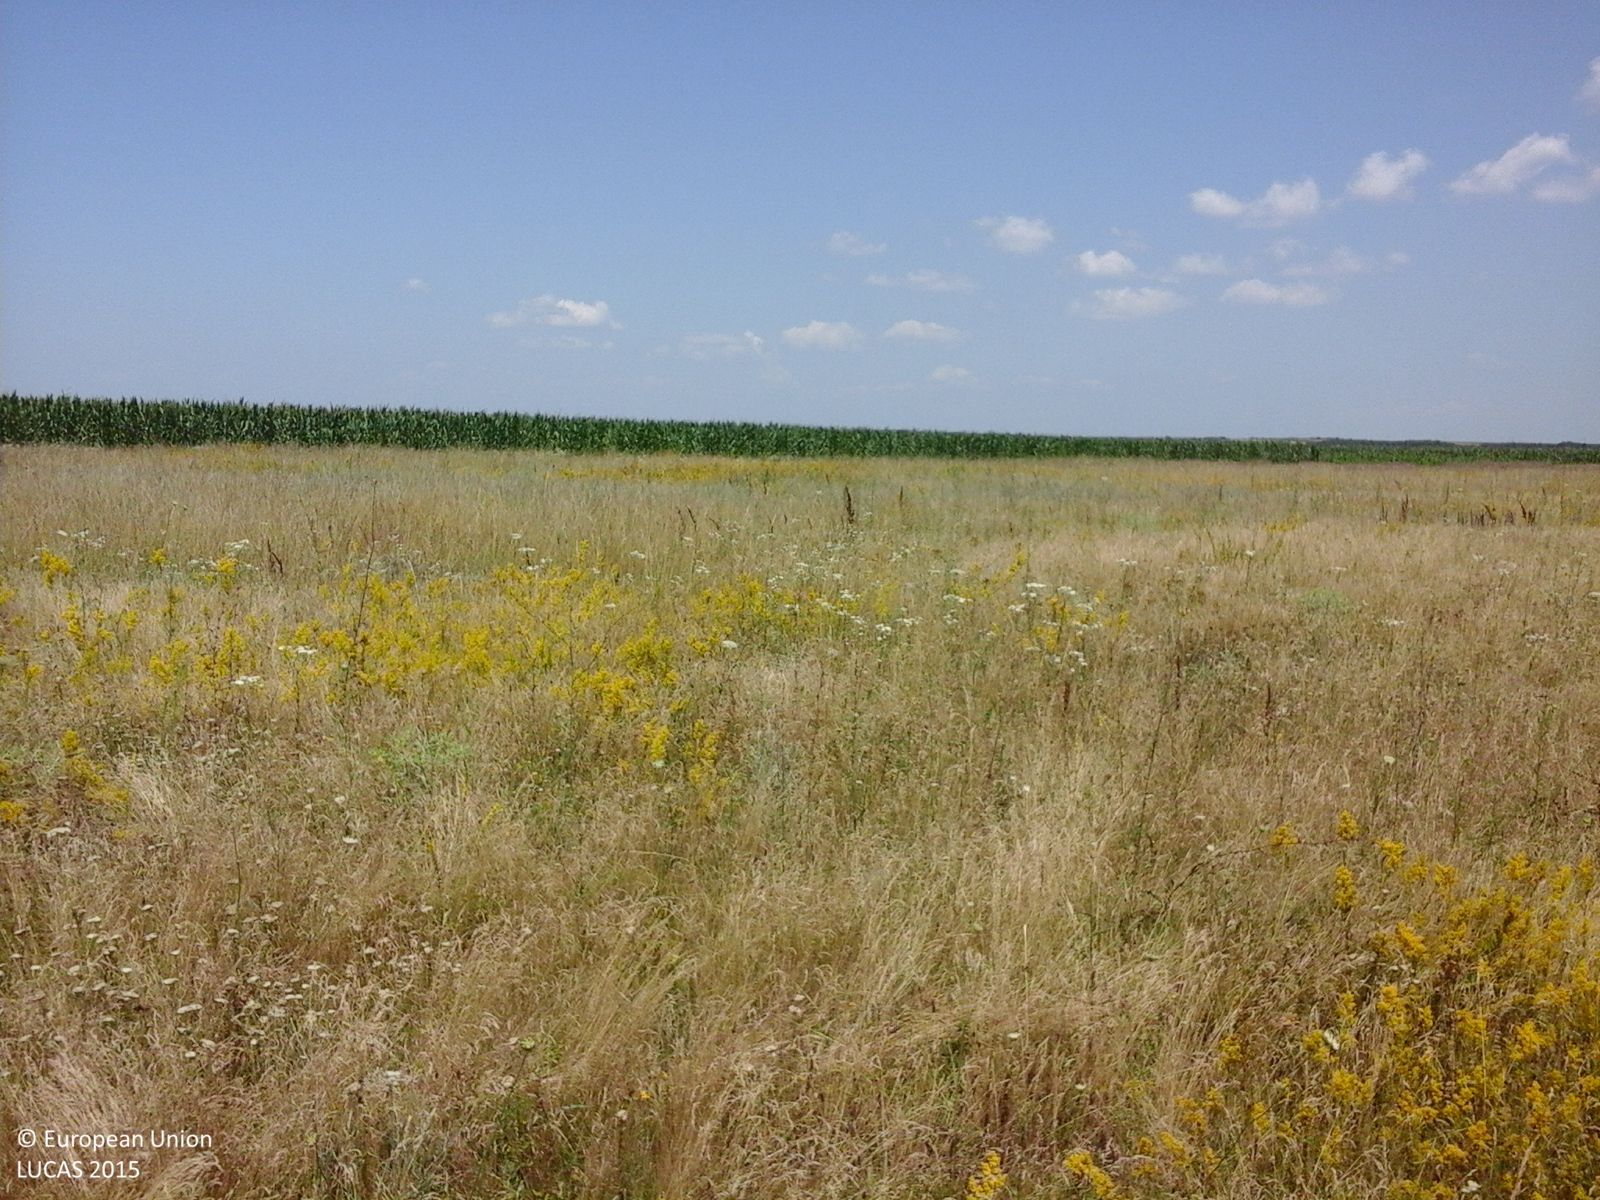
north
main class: Grassland
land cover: Spontaneously vegetated surfaces
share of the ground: > 75 %
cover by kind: herbaceous plants 100 %
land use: Fallow land
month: July
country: RO
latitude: 44.5148
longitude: 24.3724
